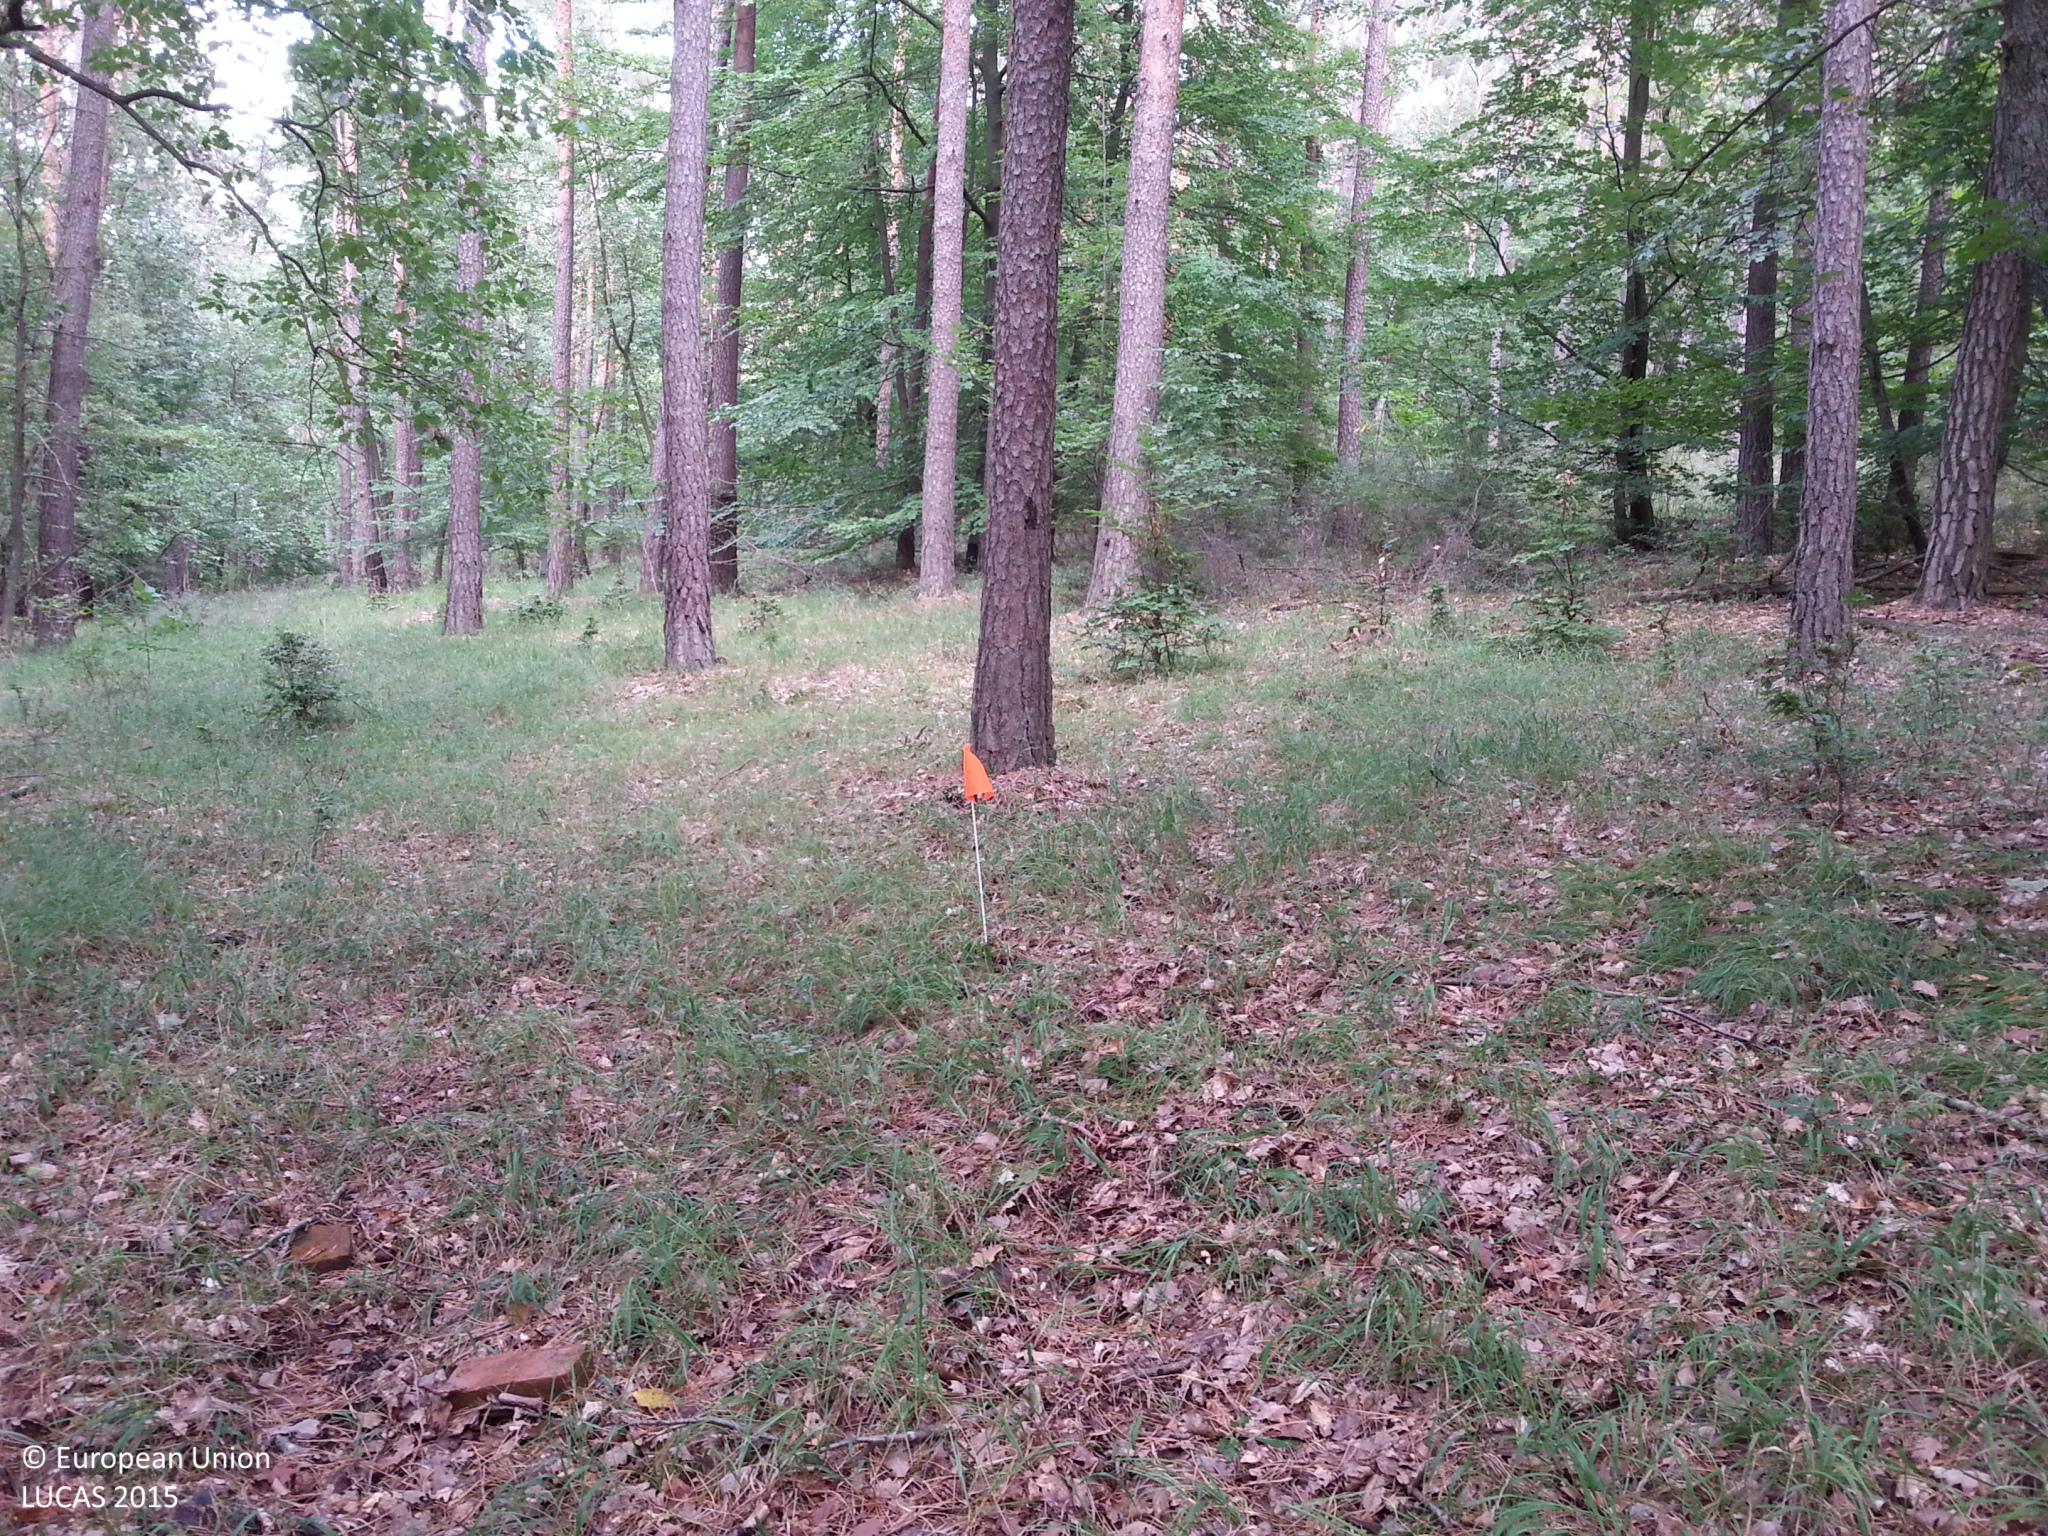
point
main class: Woodland
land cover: Pine dominated mixed woodland
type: hemiboreal forest and nemoral coniferous forest and mixed broadleaved-coniferous forest
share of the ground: > 75 %
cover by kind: coniferous forest trees 55 %, broadleaved forest trees 35 %, herbaceous plants 5 %, unconsolidated bare surface 5 %
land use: Forestry
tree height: > 5 m
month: September
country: DE
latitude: 49.6619
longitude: 9.5707
